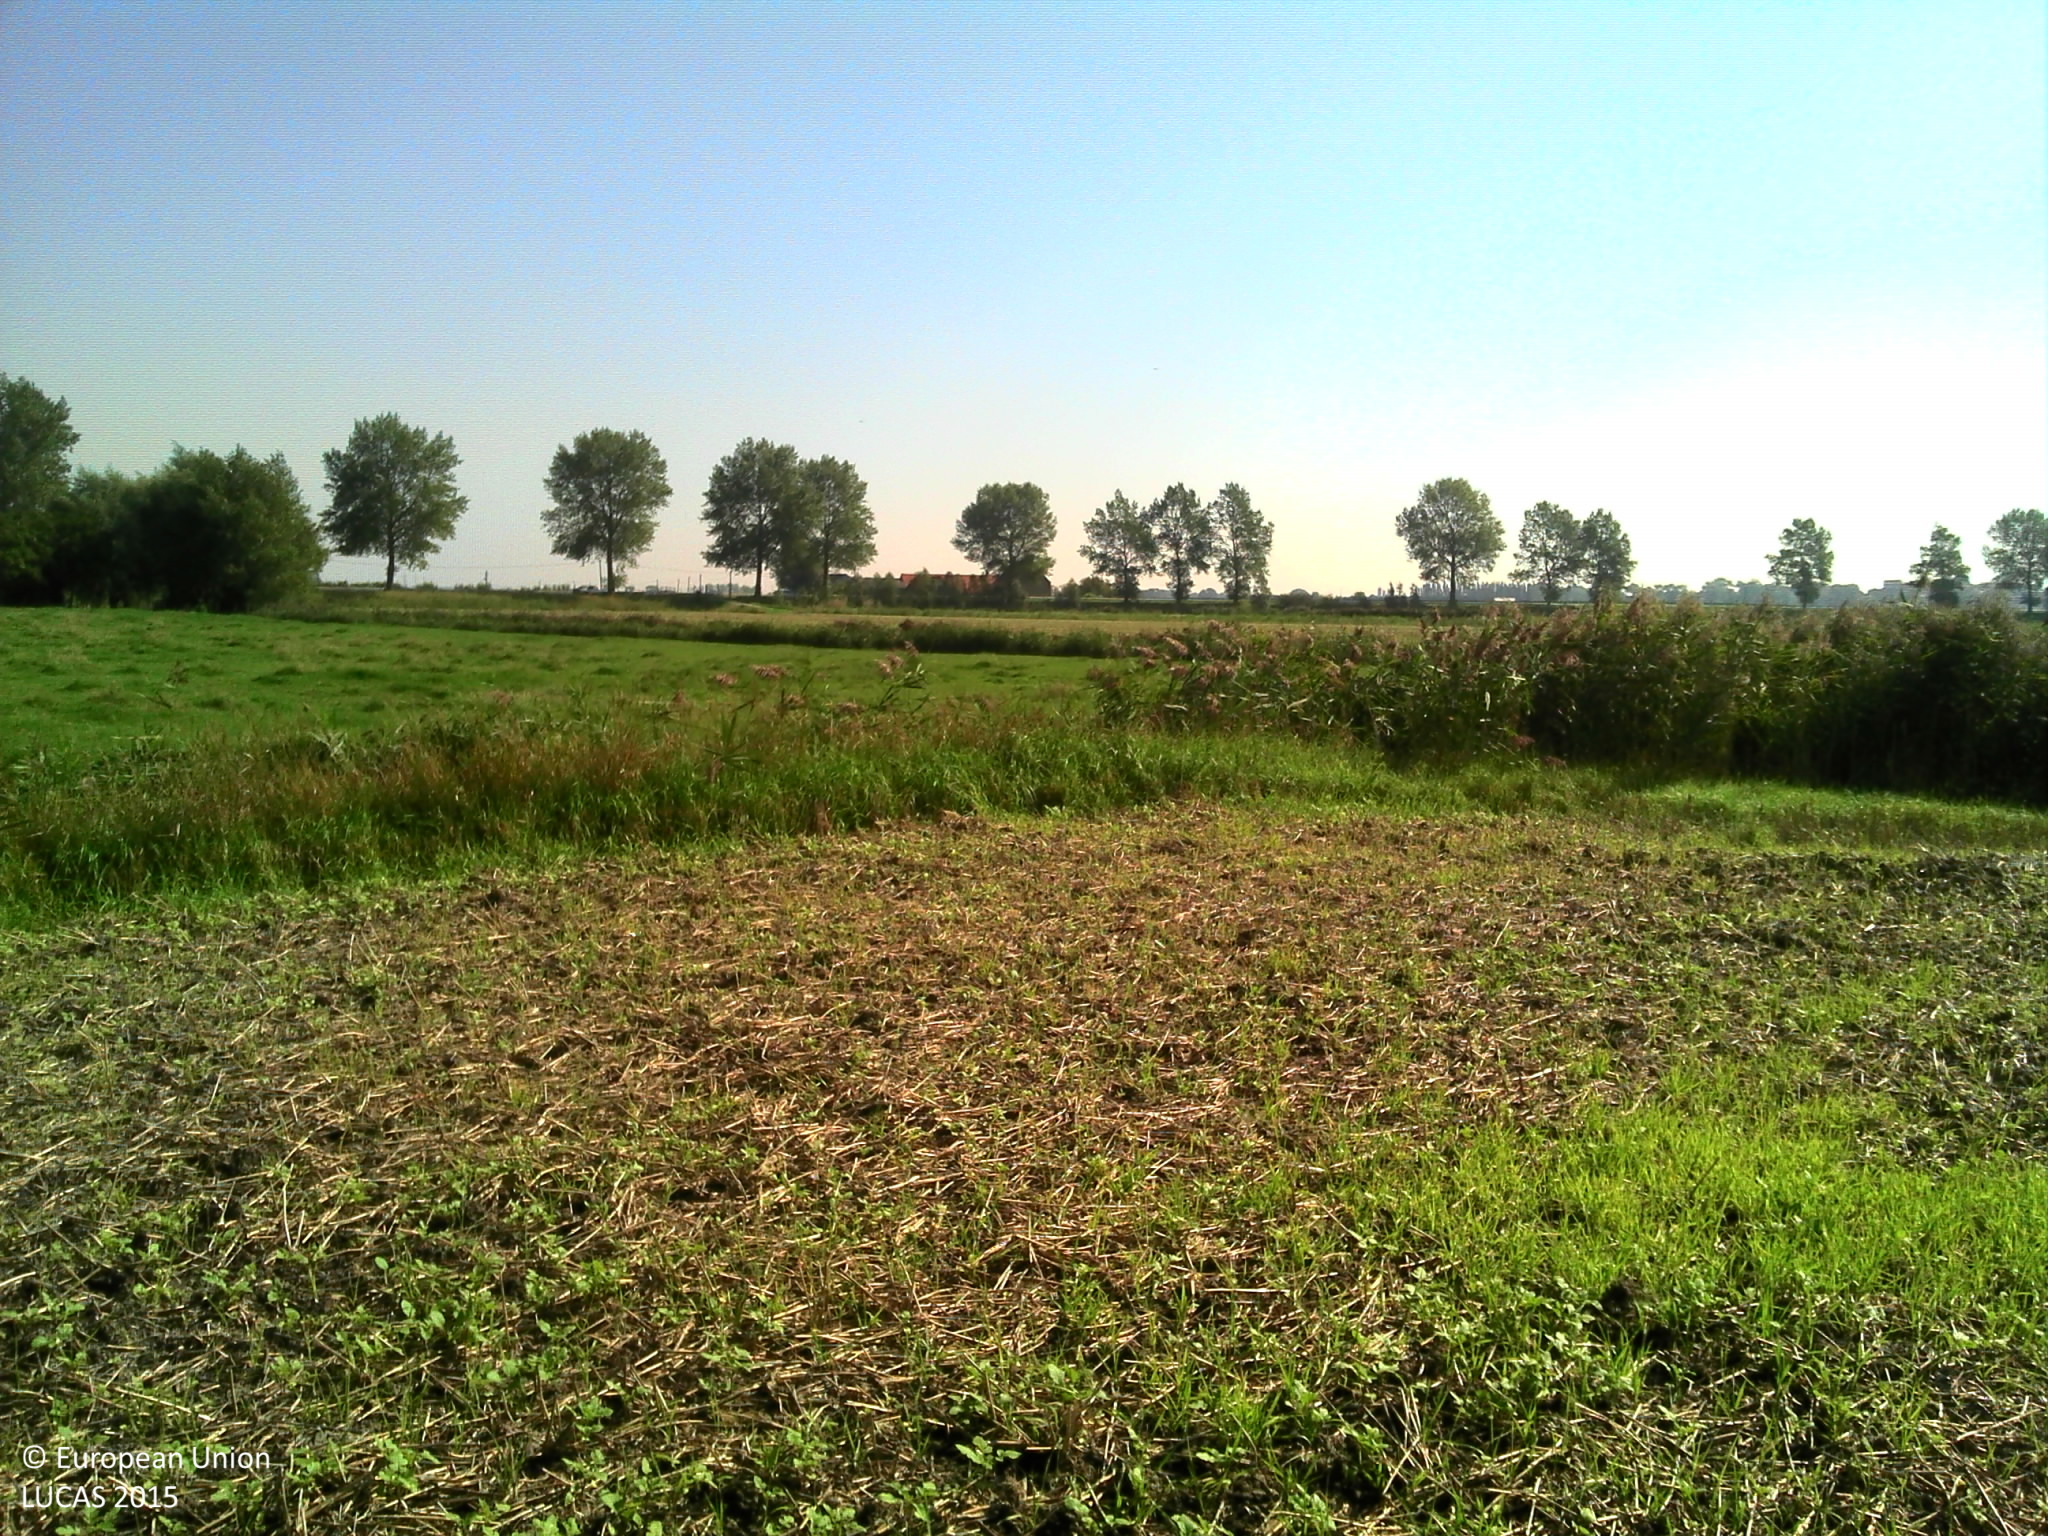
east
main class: Cropland
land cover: Other fibre and oleaginous crops
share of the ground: 50 - 75 %
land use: Agriculture (excluding fallow land and kitchen gardens)
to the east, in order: Other fibre and oleaginous crops; Grass margins; Ditches and canals; Fences; Grassland without tree/shrub cover; Fences; Ditches and canals; Other fibre and oleaginous crops; Ditches and canals; Grass margins; Tracks; Grass margins; Ditches and canals; Other fibre and oleaginous crops
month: September
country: BE
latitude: 51.0424
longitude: 2.8434
